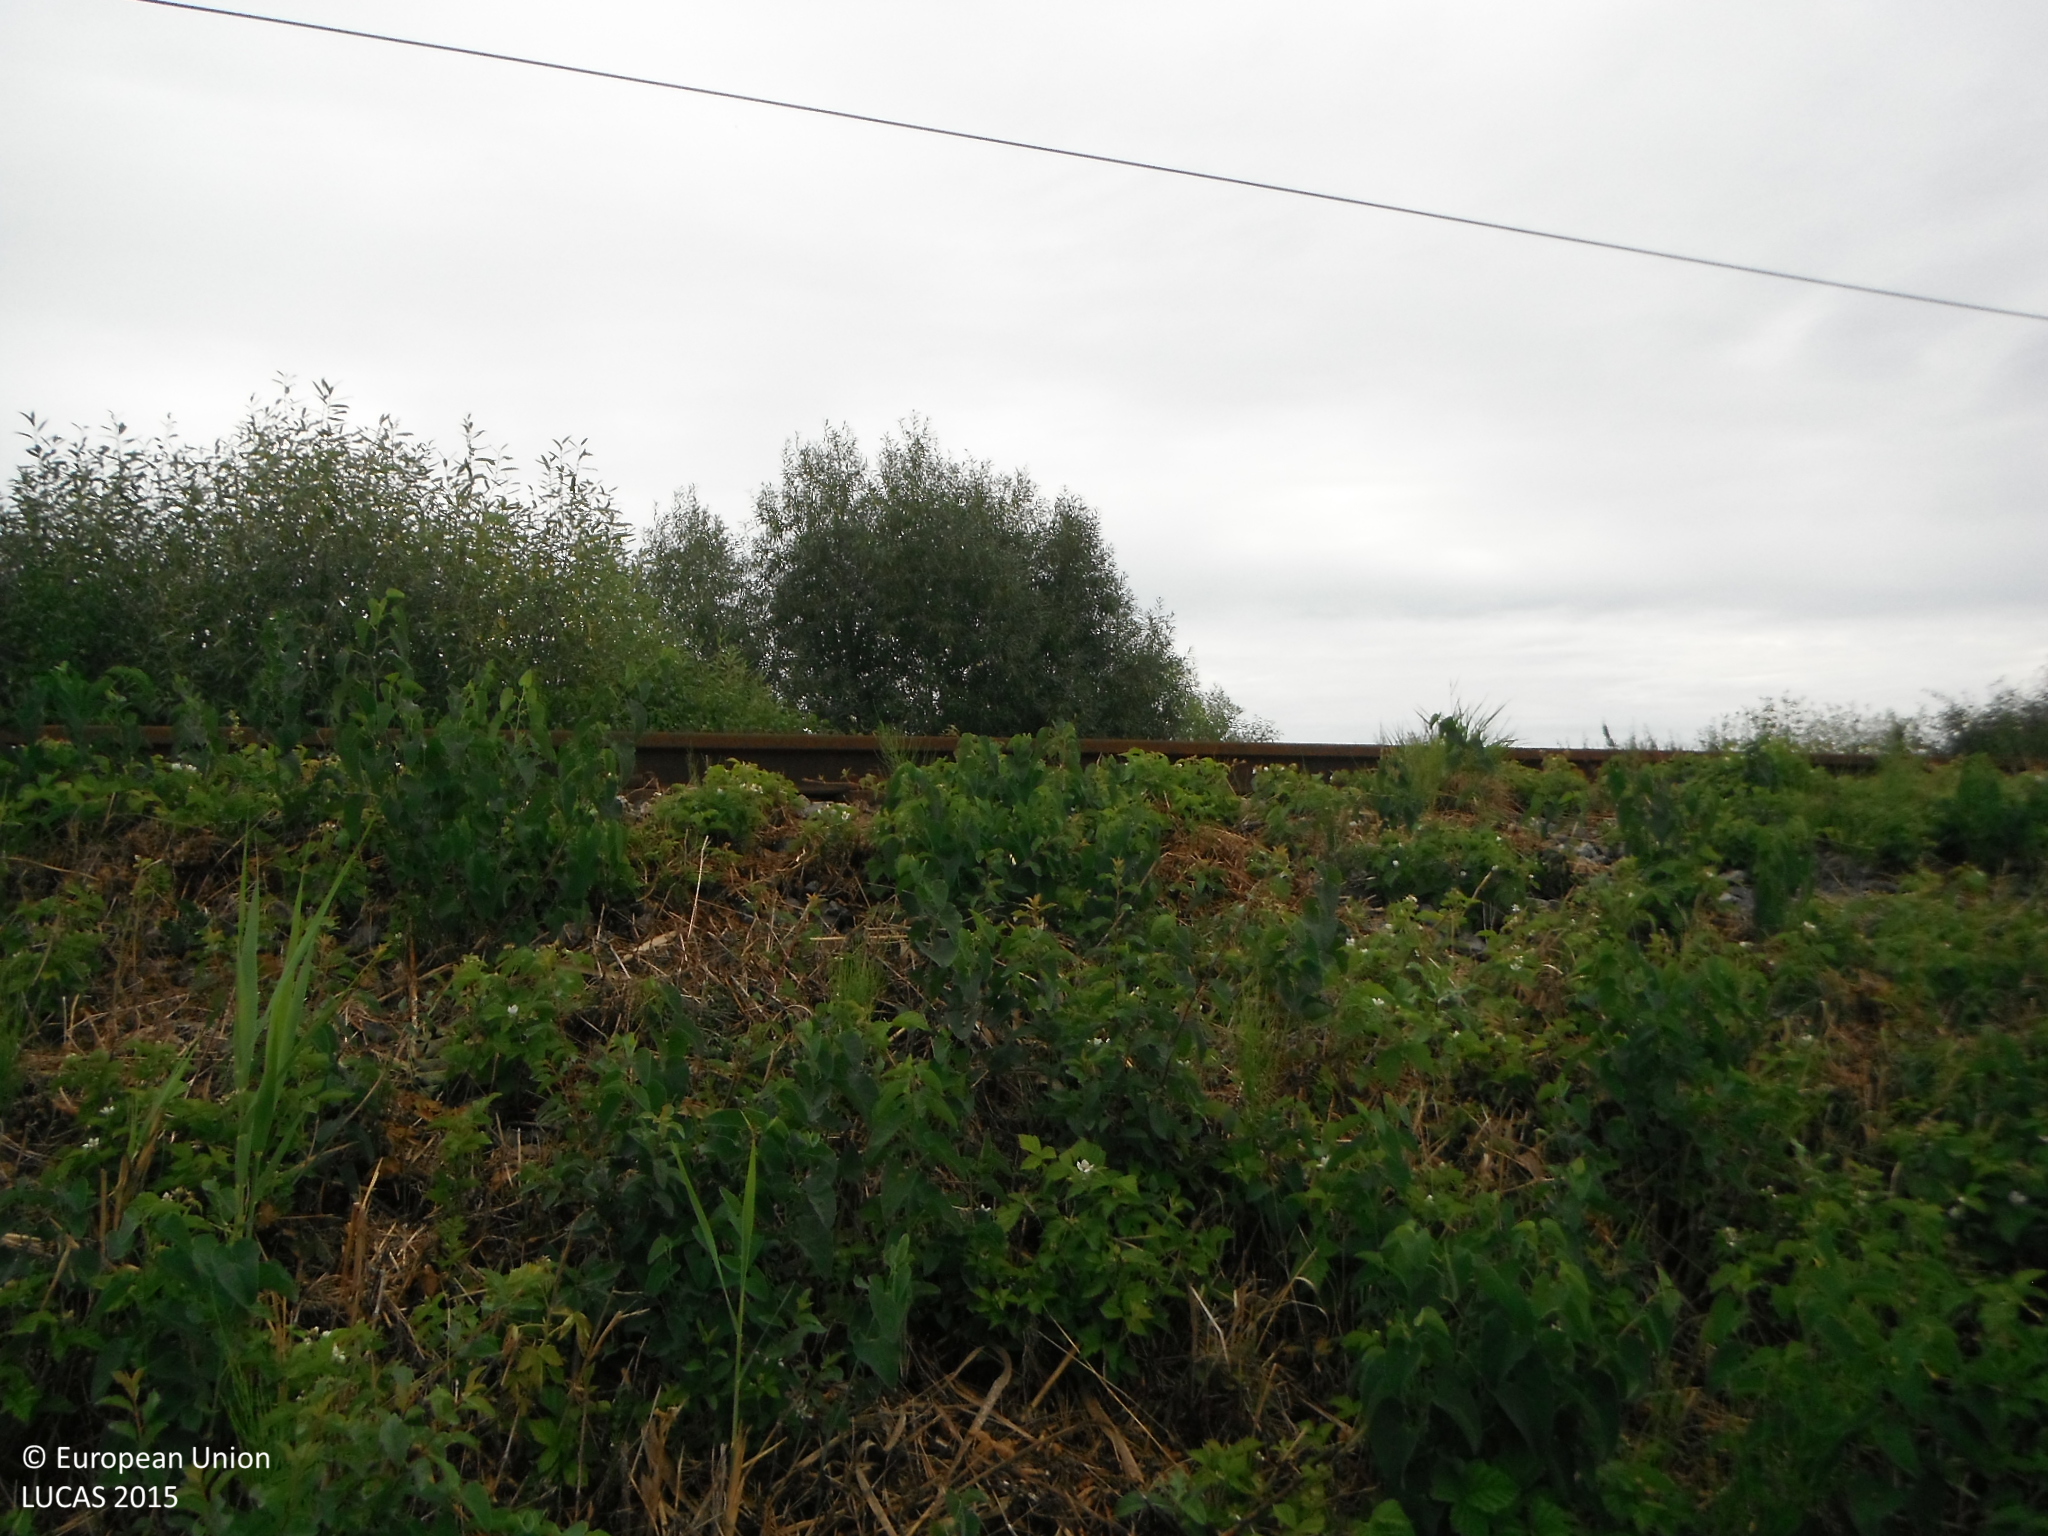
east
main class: Shrubland
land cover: Shrubland with sparse tree cover
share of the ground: > 75 %
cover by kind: shrubs 95 %, broadleaved forest trees 5 %
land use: Semi-natural and natural areas not in use
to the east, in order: Shrubland with sparse tree cover; Spontaneously vegetated surfaces; Electric lines; Spontaneously vegetated surfaces; Railways; Spontaneously vegetated surfaces; Shrubland with sparse tree cover; Common wheat
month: July
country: SK
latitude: 48.6352
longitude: 18.2796
